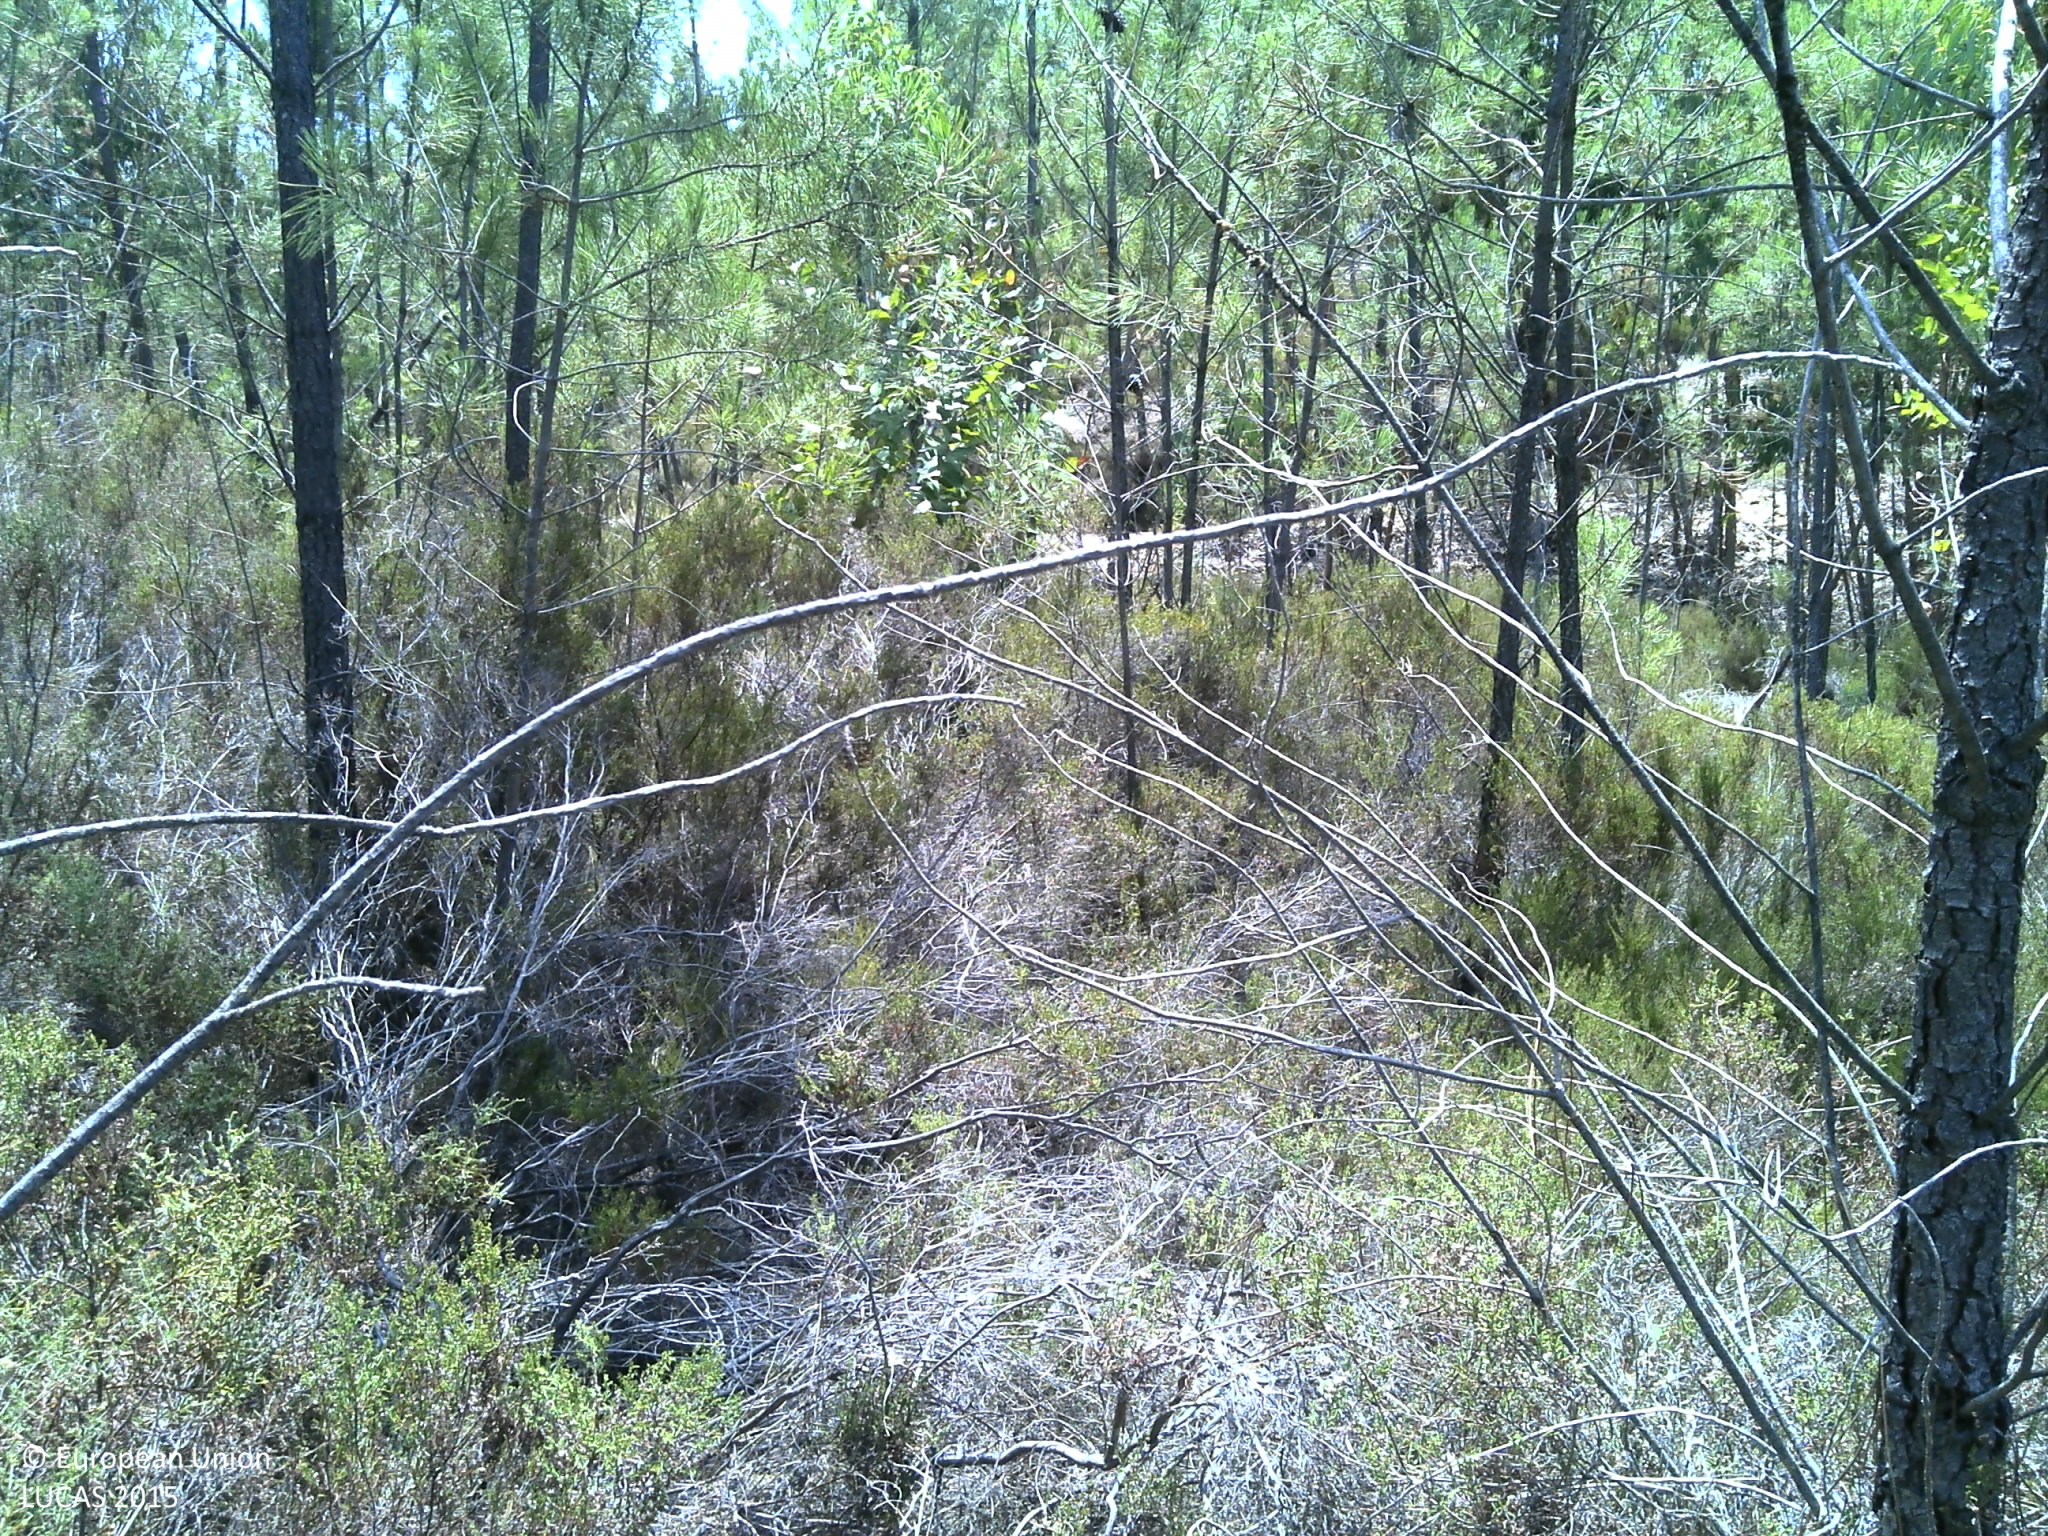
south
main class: Woodland
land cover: Pine dominated coniferous woodland
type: coniferous forest of the mediterranean region
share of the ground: 25 - 50 %
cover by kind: shrubs 55 %, coniferous forest trees 30 %, unconsolidated bare surface 10 %, consolidated bare surface 5 %
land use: Forestry
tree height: > 5 m
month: July
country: PT
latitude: 39.5802
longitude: -8.0255
